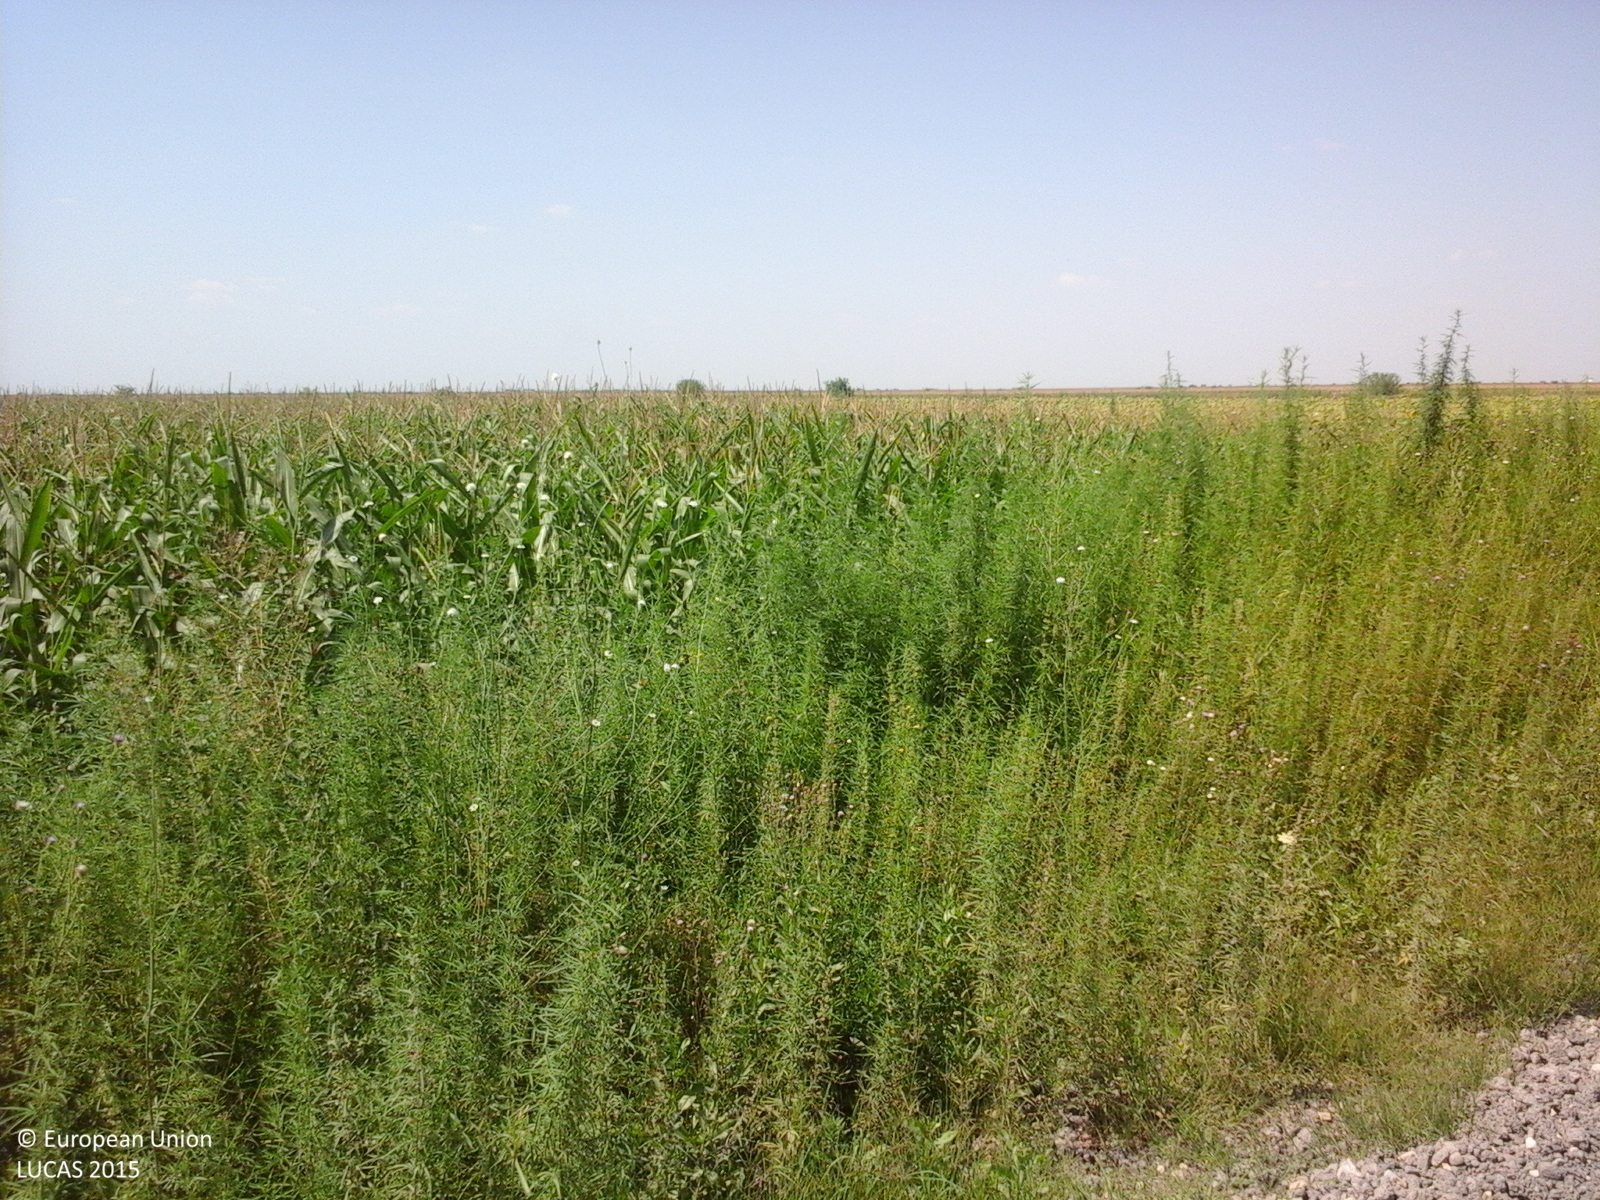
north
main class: Cropland
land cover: Maize
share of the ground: > 75 %
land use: Agriculture (excluding fallow land and kitchen gardens)
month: July
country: RO
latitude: 44.4436
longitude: 27.0029
